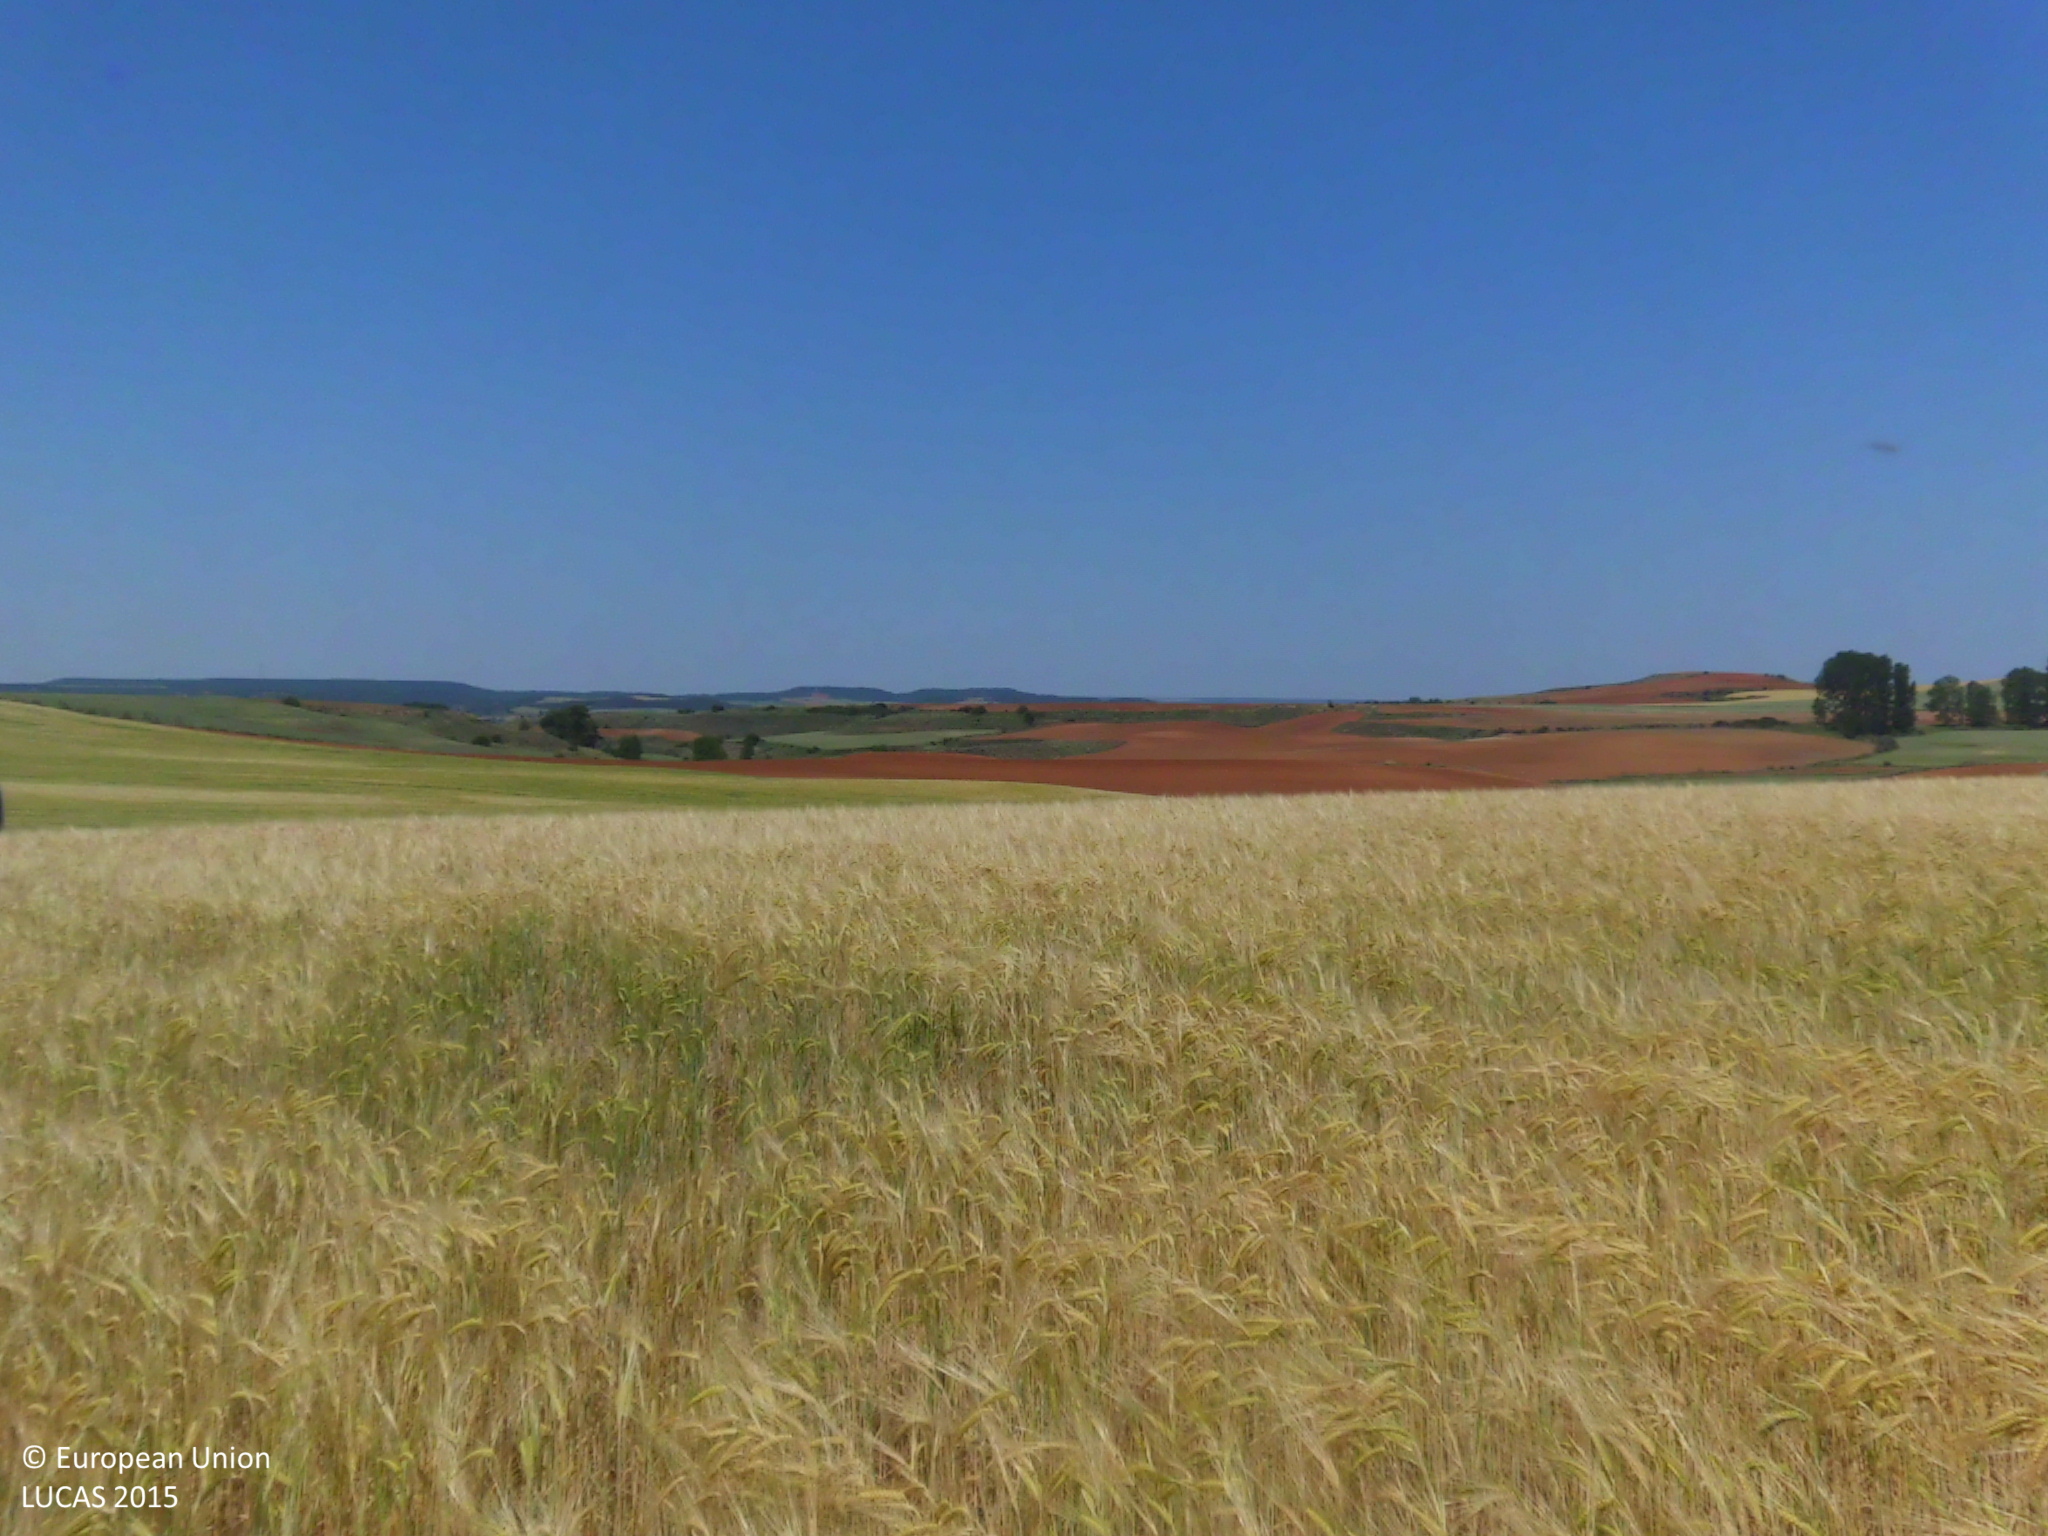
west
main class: Cropland
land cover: Barley
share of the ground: > 75 %
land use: Agriculture (excluding fallow land and kitchen gardens)
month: June
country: ES
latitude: 42.5402
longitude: -4.2323
